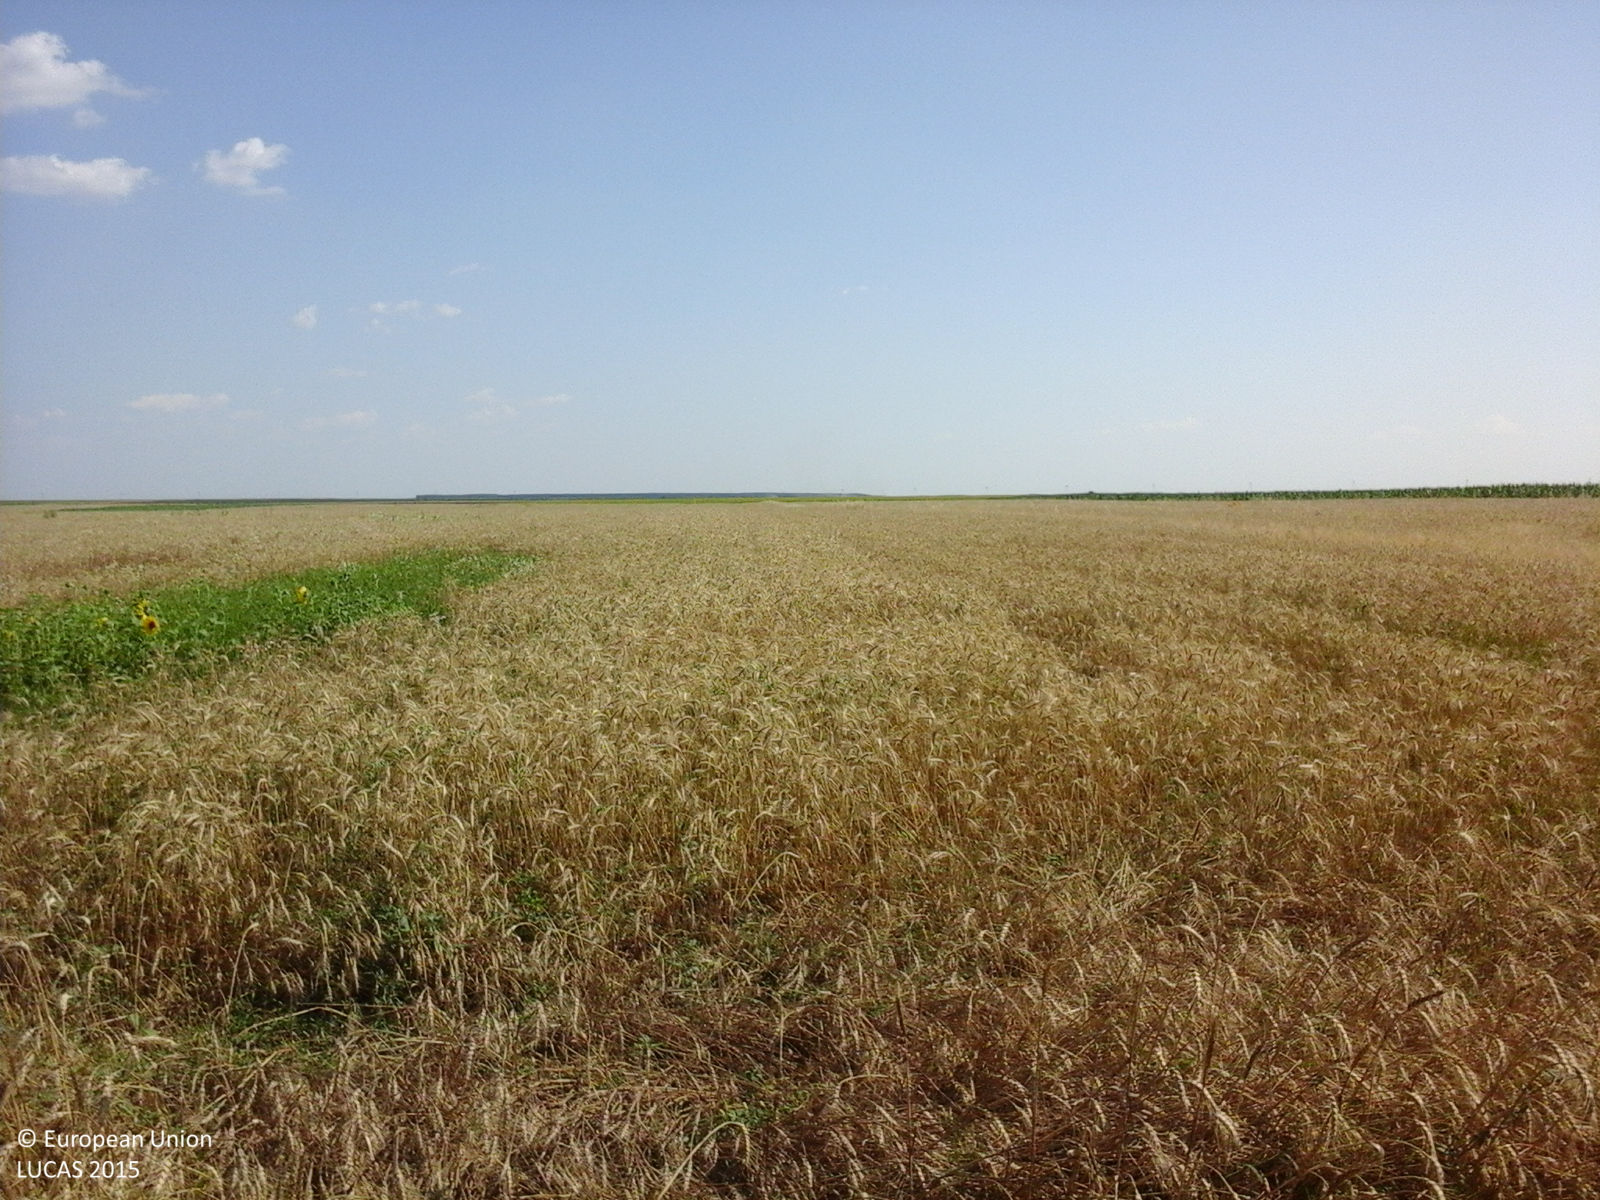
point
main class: Cropland
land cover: Common wheat
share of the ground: > 75 %
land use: Agriculture (excluding fallow land and kitchen gardens)
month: July
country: RO
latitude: 44.3707
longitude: 24.6168
